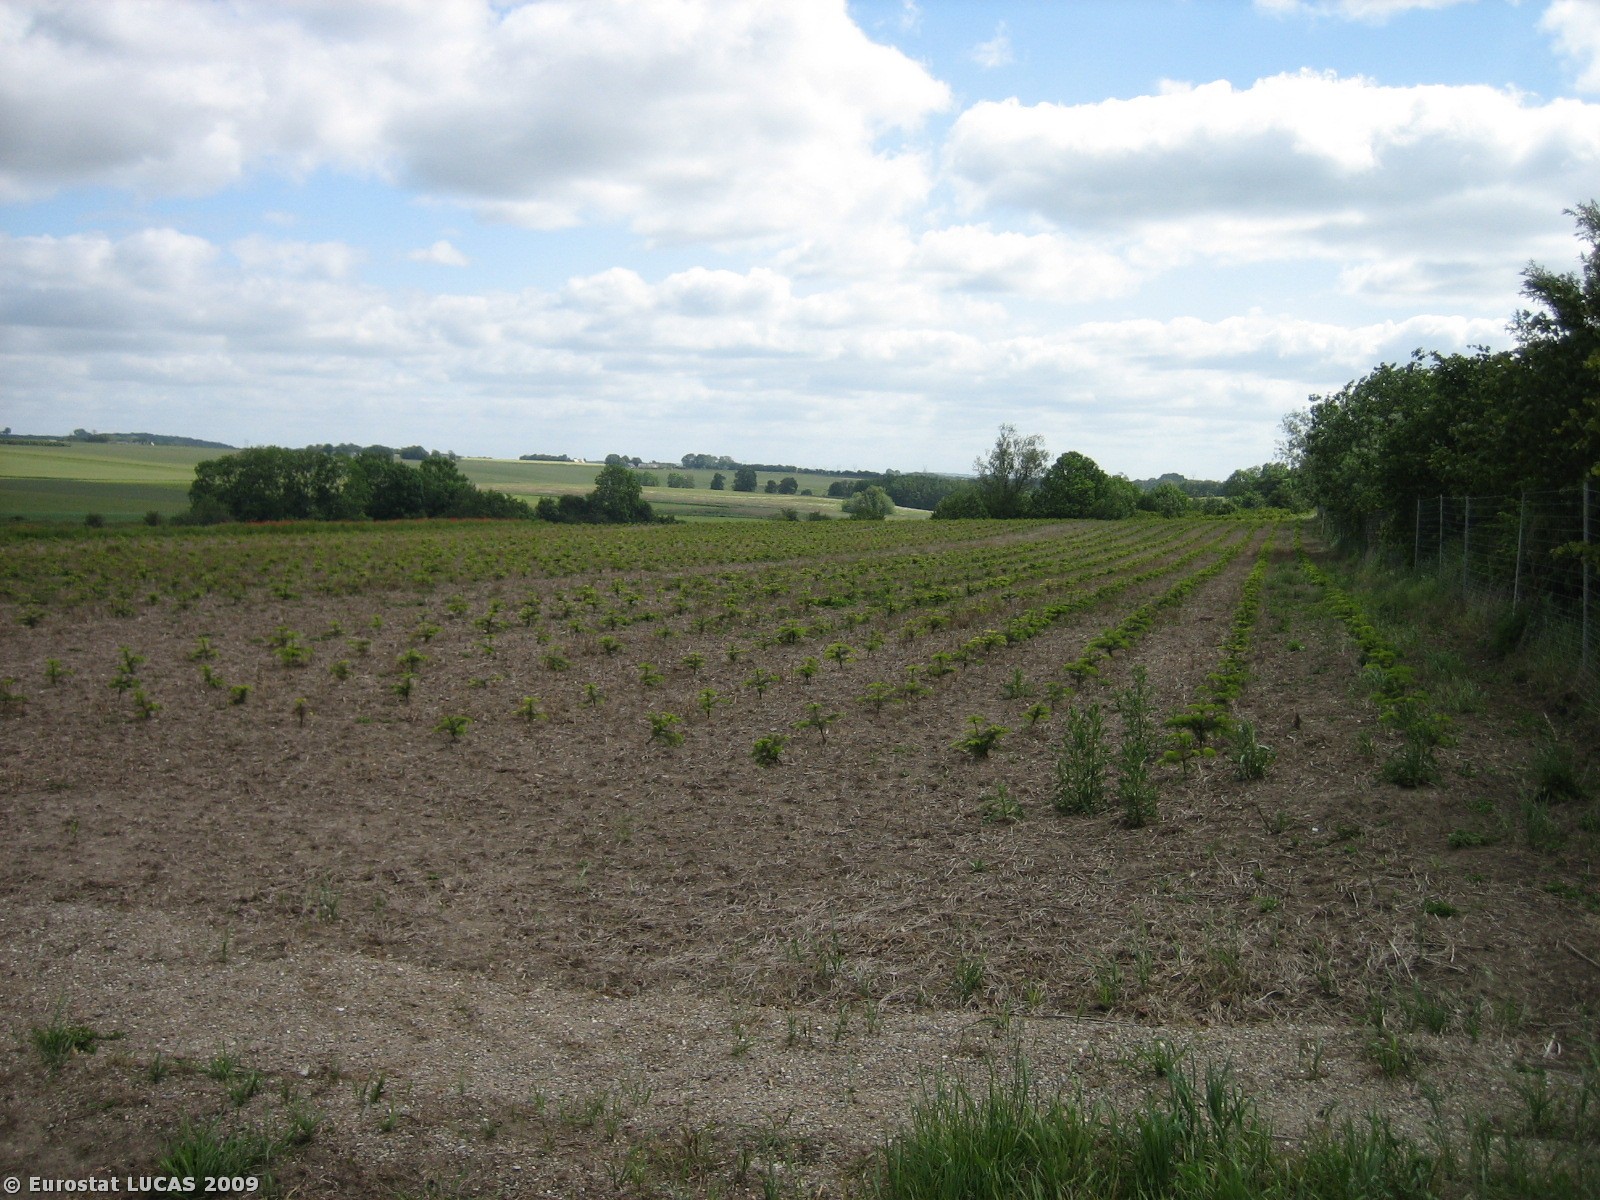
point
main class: Woodland
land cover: Coniferous woodland
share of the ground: 10 - 25 %
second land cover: Bare land
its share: > 75 %
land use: Agriculture (excluding fallow land and kitchen gardens)
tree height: < 5 m
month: June
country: DK
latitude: 55.8638
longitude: 9.6967
